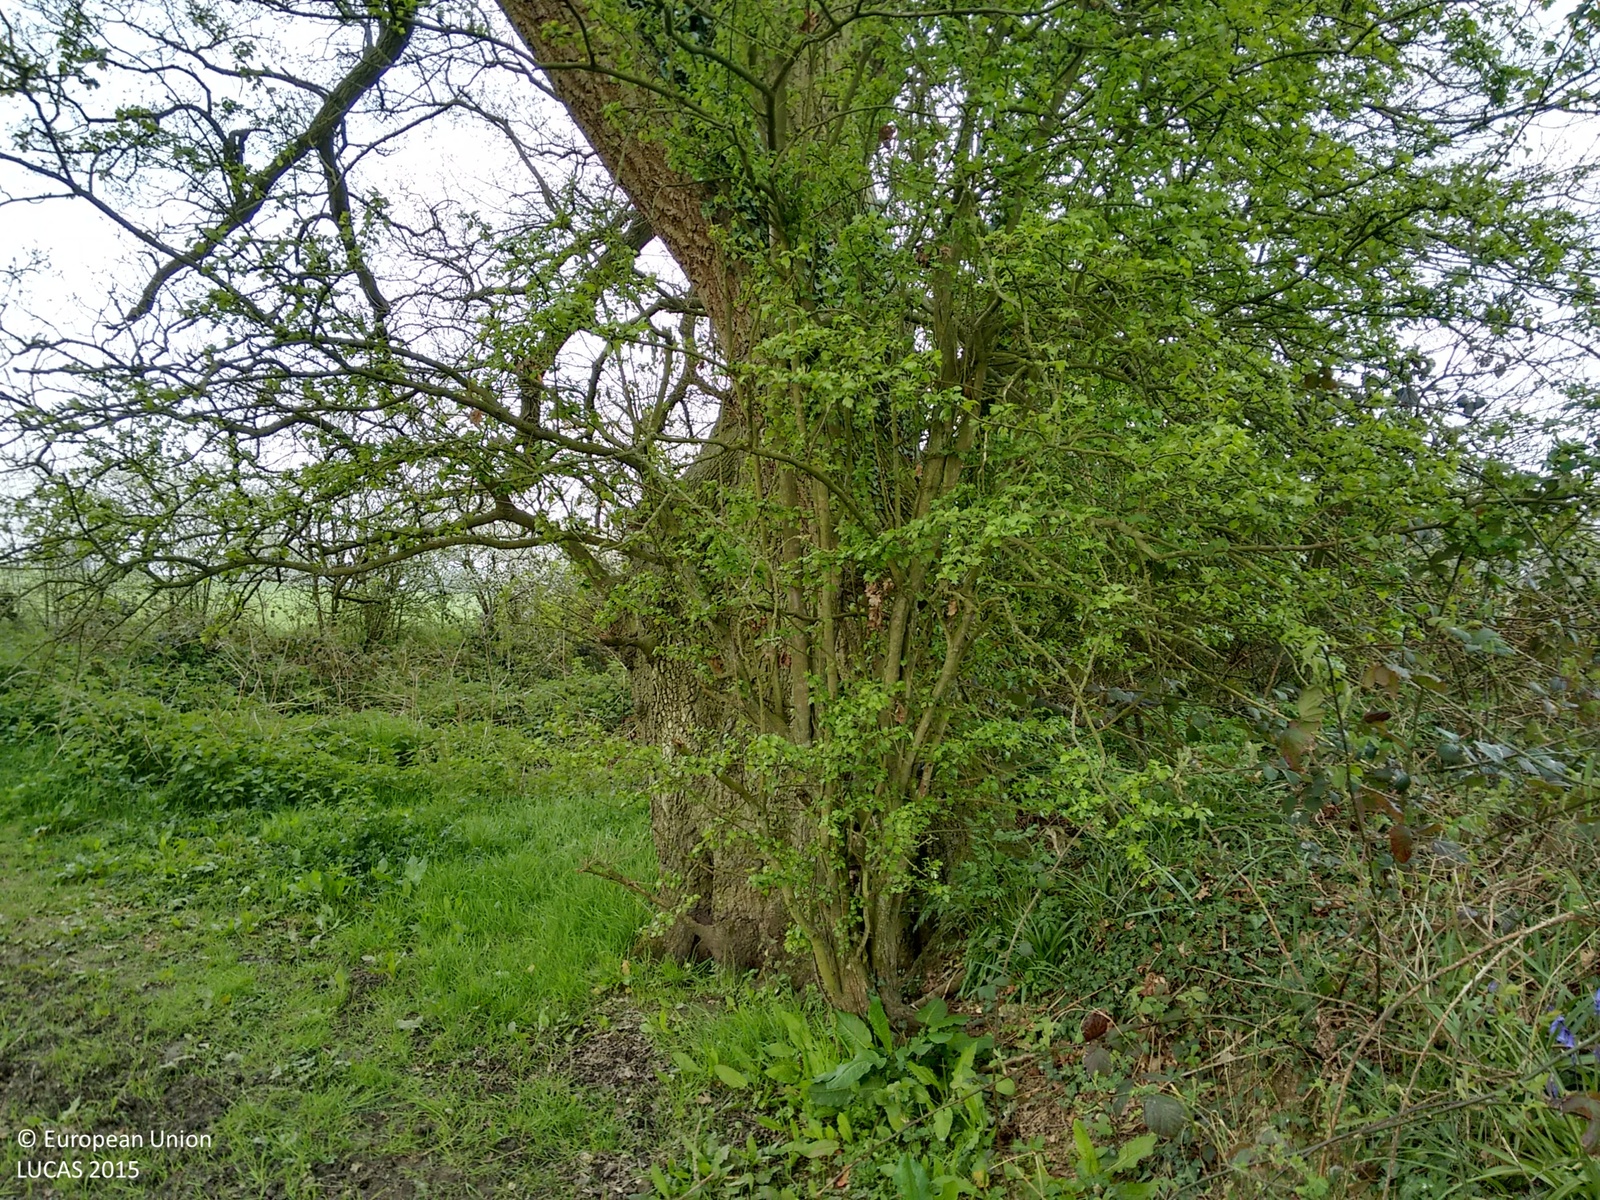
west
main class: Woodland
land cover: Broadleaved woodland
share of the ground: > 75 %
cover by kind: broadleaved forest trees 95 %, consolidated bare surface 5 %
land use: Semi-natural and natural areas not in use
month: April
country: GB
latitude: 51.6544
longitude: -0.7229
